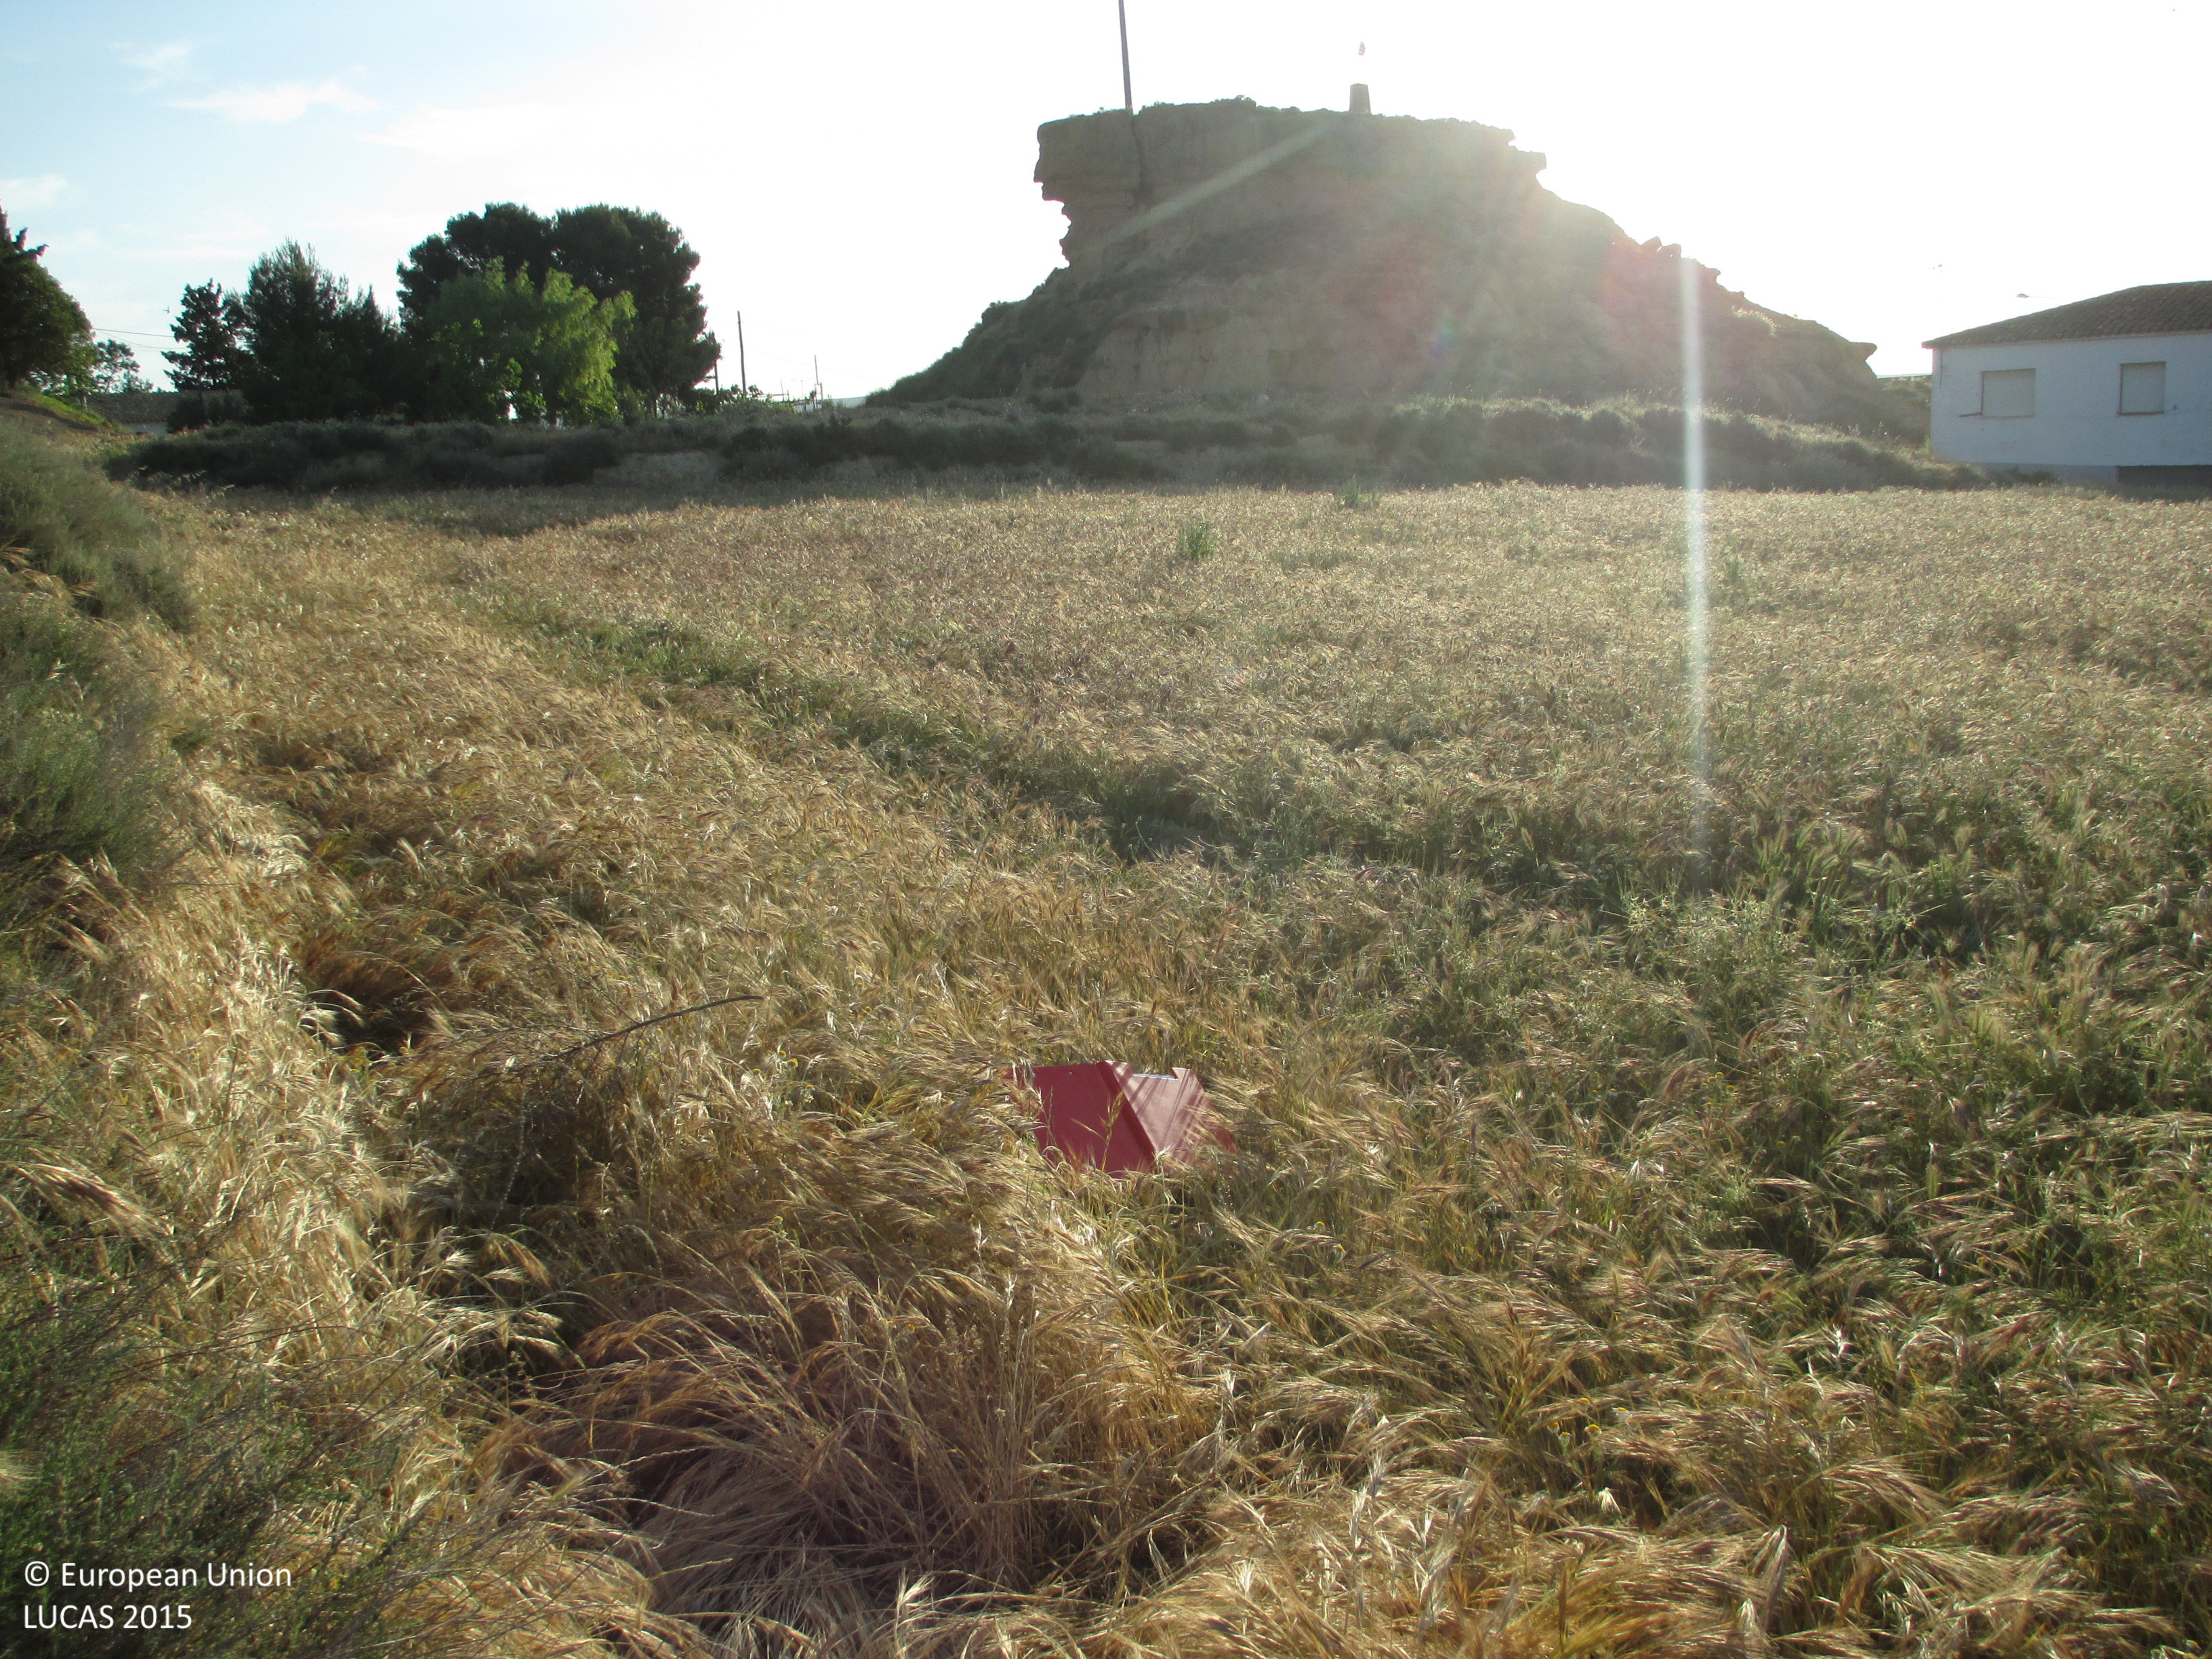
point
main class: Grassland
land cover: Spontaneously vegetated surfaces
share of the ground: > 75 %
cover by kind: herbaceous plants 100 %
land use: Fallow land
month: May
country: ES
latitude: 41.9933
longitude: -0.3664
